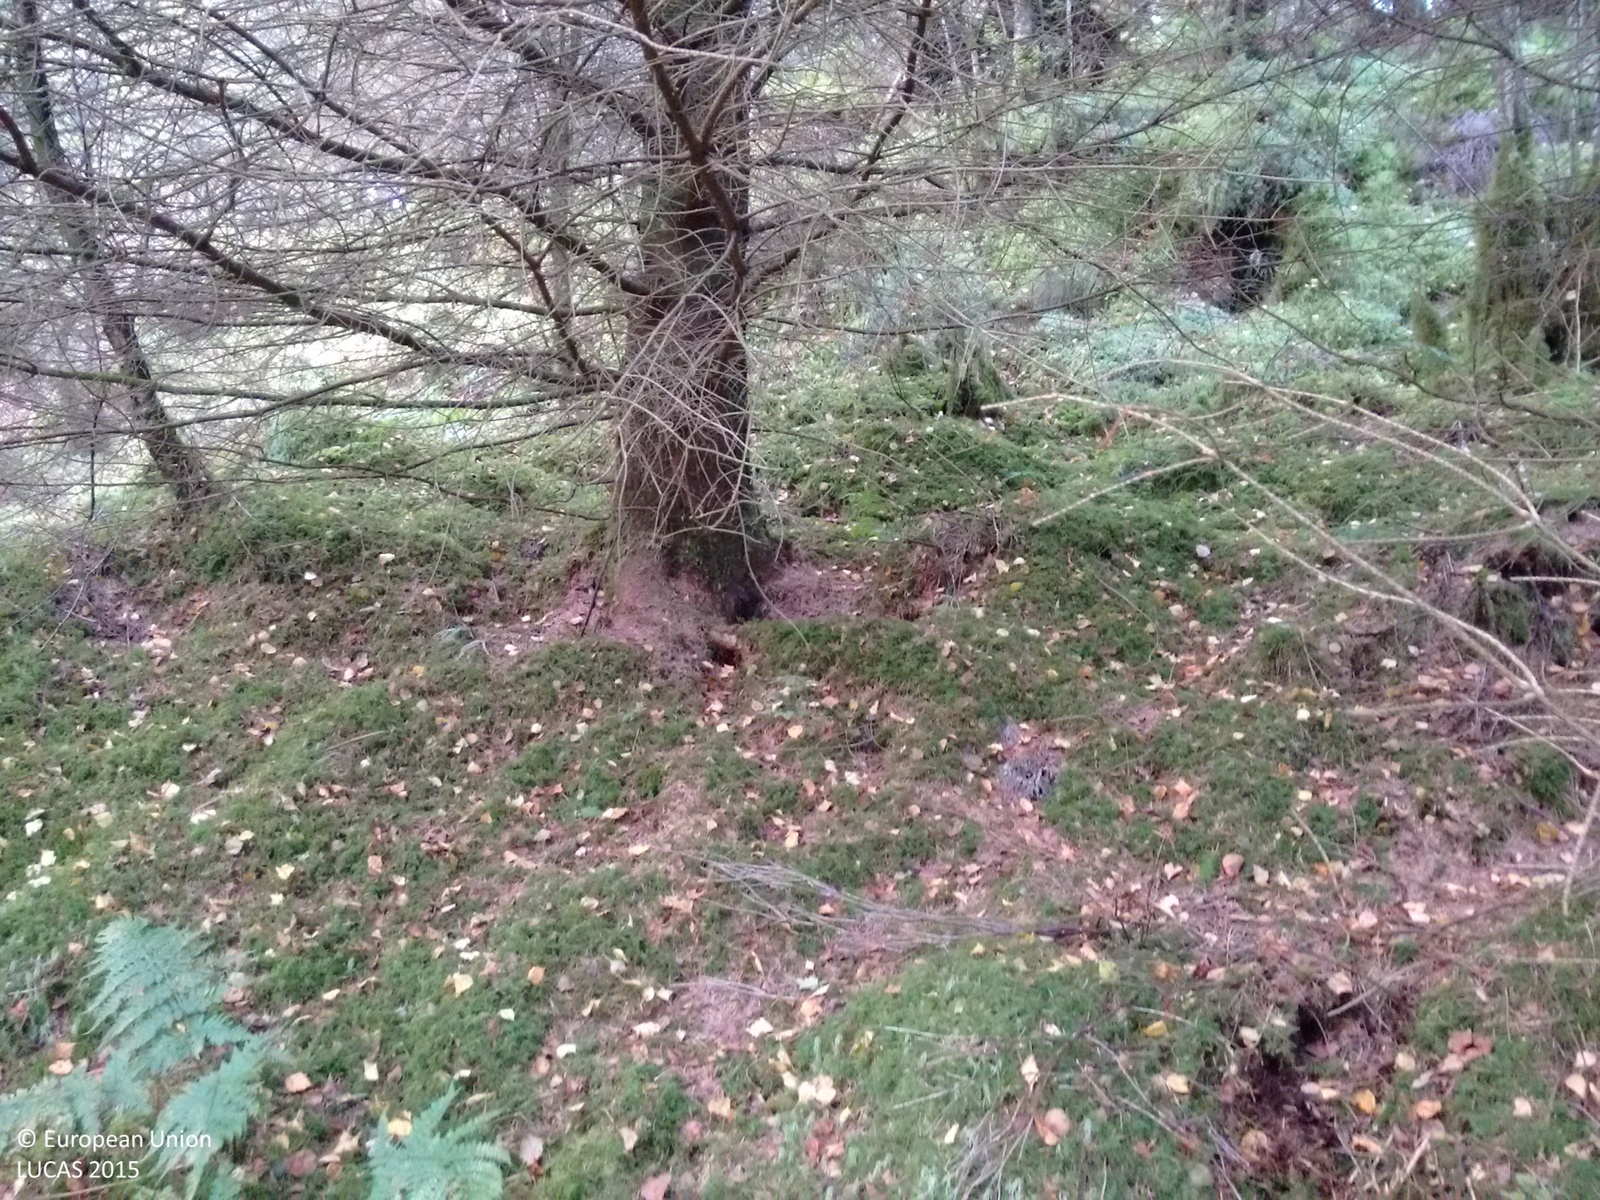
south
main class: Woodland
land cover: Pine dominated coniferous woodland
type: exotic forest
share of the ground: > 75 %
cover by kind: coniferous forest trees 100 %
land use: Forestry
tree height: > 5 m
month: October
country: GB
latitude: 52.5217
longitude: -3.9020
